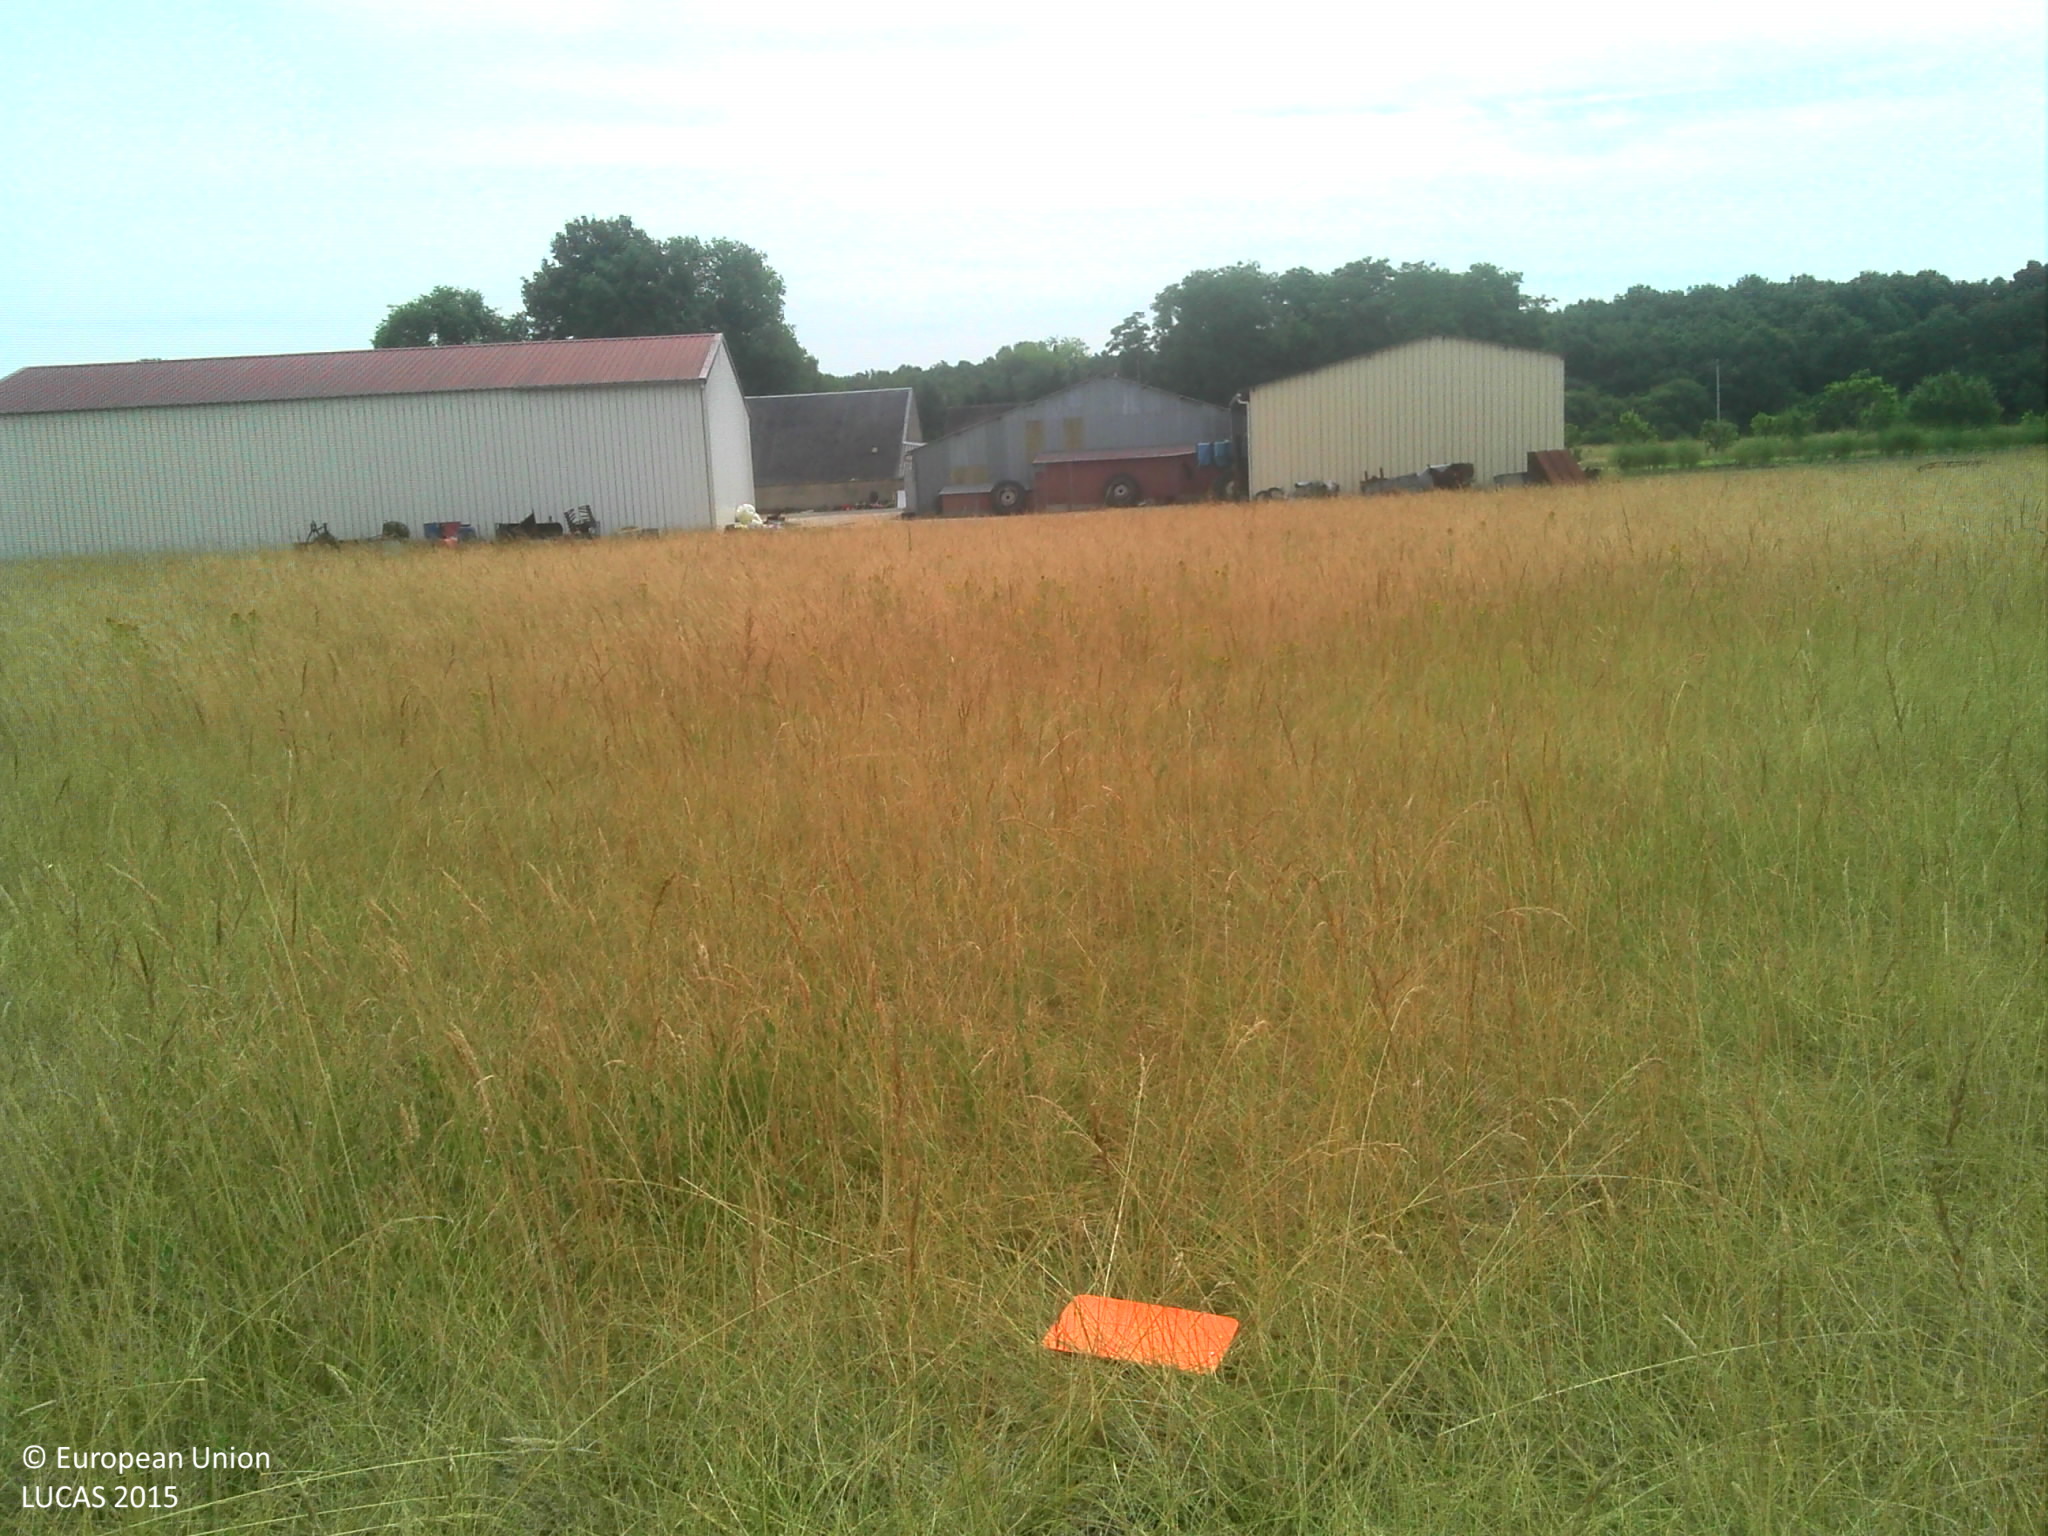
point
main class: Grassland
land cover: Grassland without tree/shrub cover
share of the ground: > 75 %
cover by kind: herbaceous plants 100 %
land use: Agriculture (excluding fallow land and kitchen gardens)
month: June
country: FR
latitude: 47.3616
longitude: 1.3928
